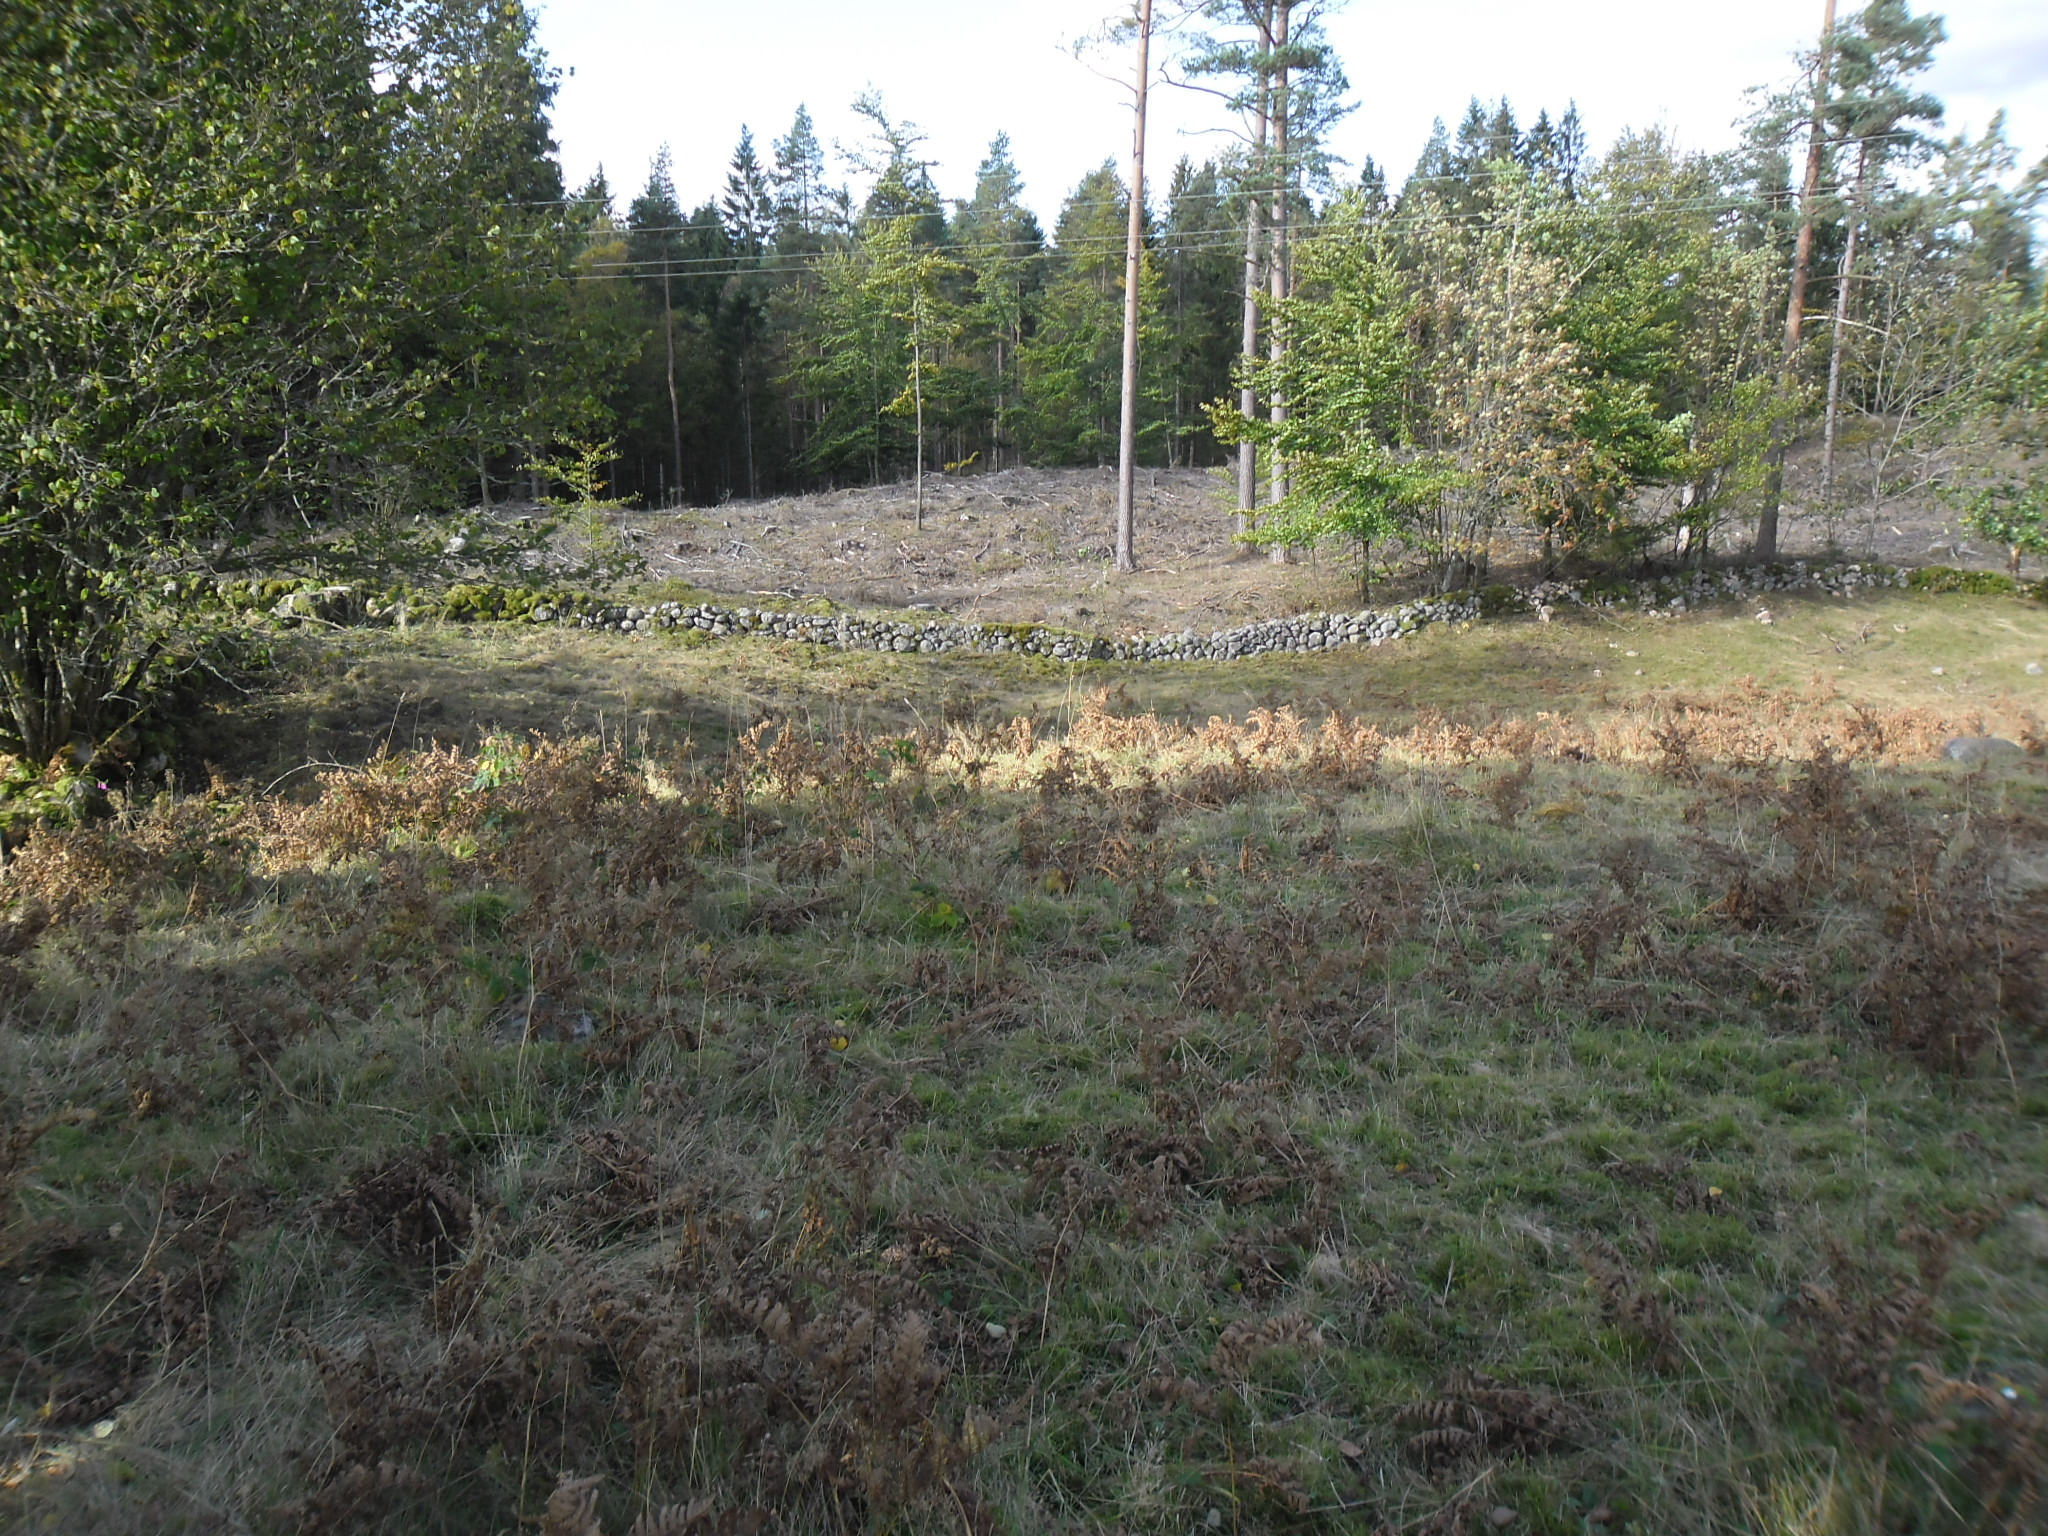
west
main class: Grassland
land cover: Grassland without tree/shrub cover
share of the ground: > 75 %
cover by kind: herbaceous plants 100 %
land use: Agriculture (excluding fallow land and kitchen gardens)
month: October
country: SE
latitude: 56.6897
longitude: 13.1152
